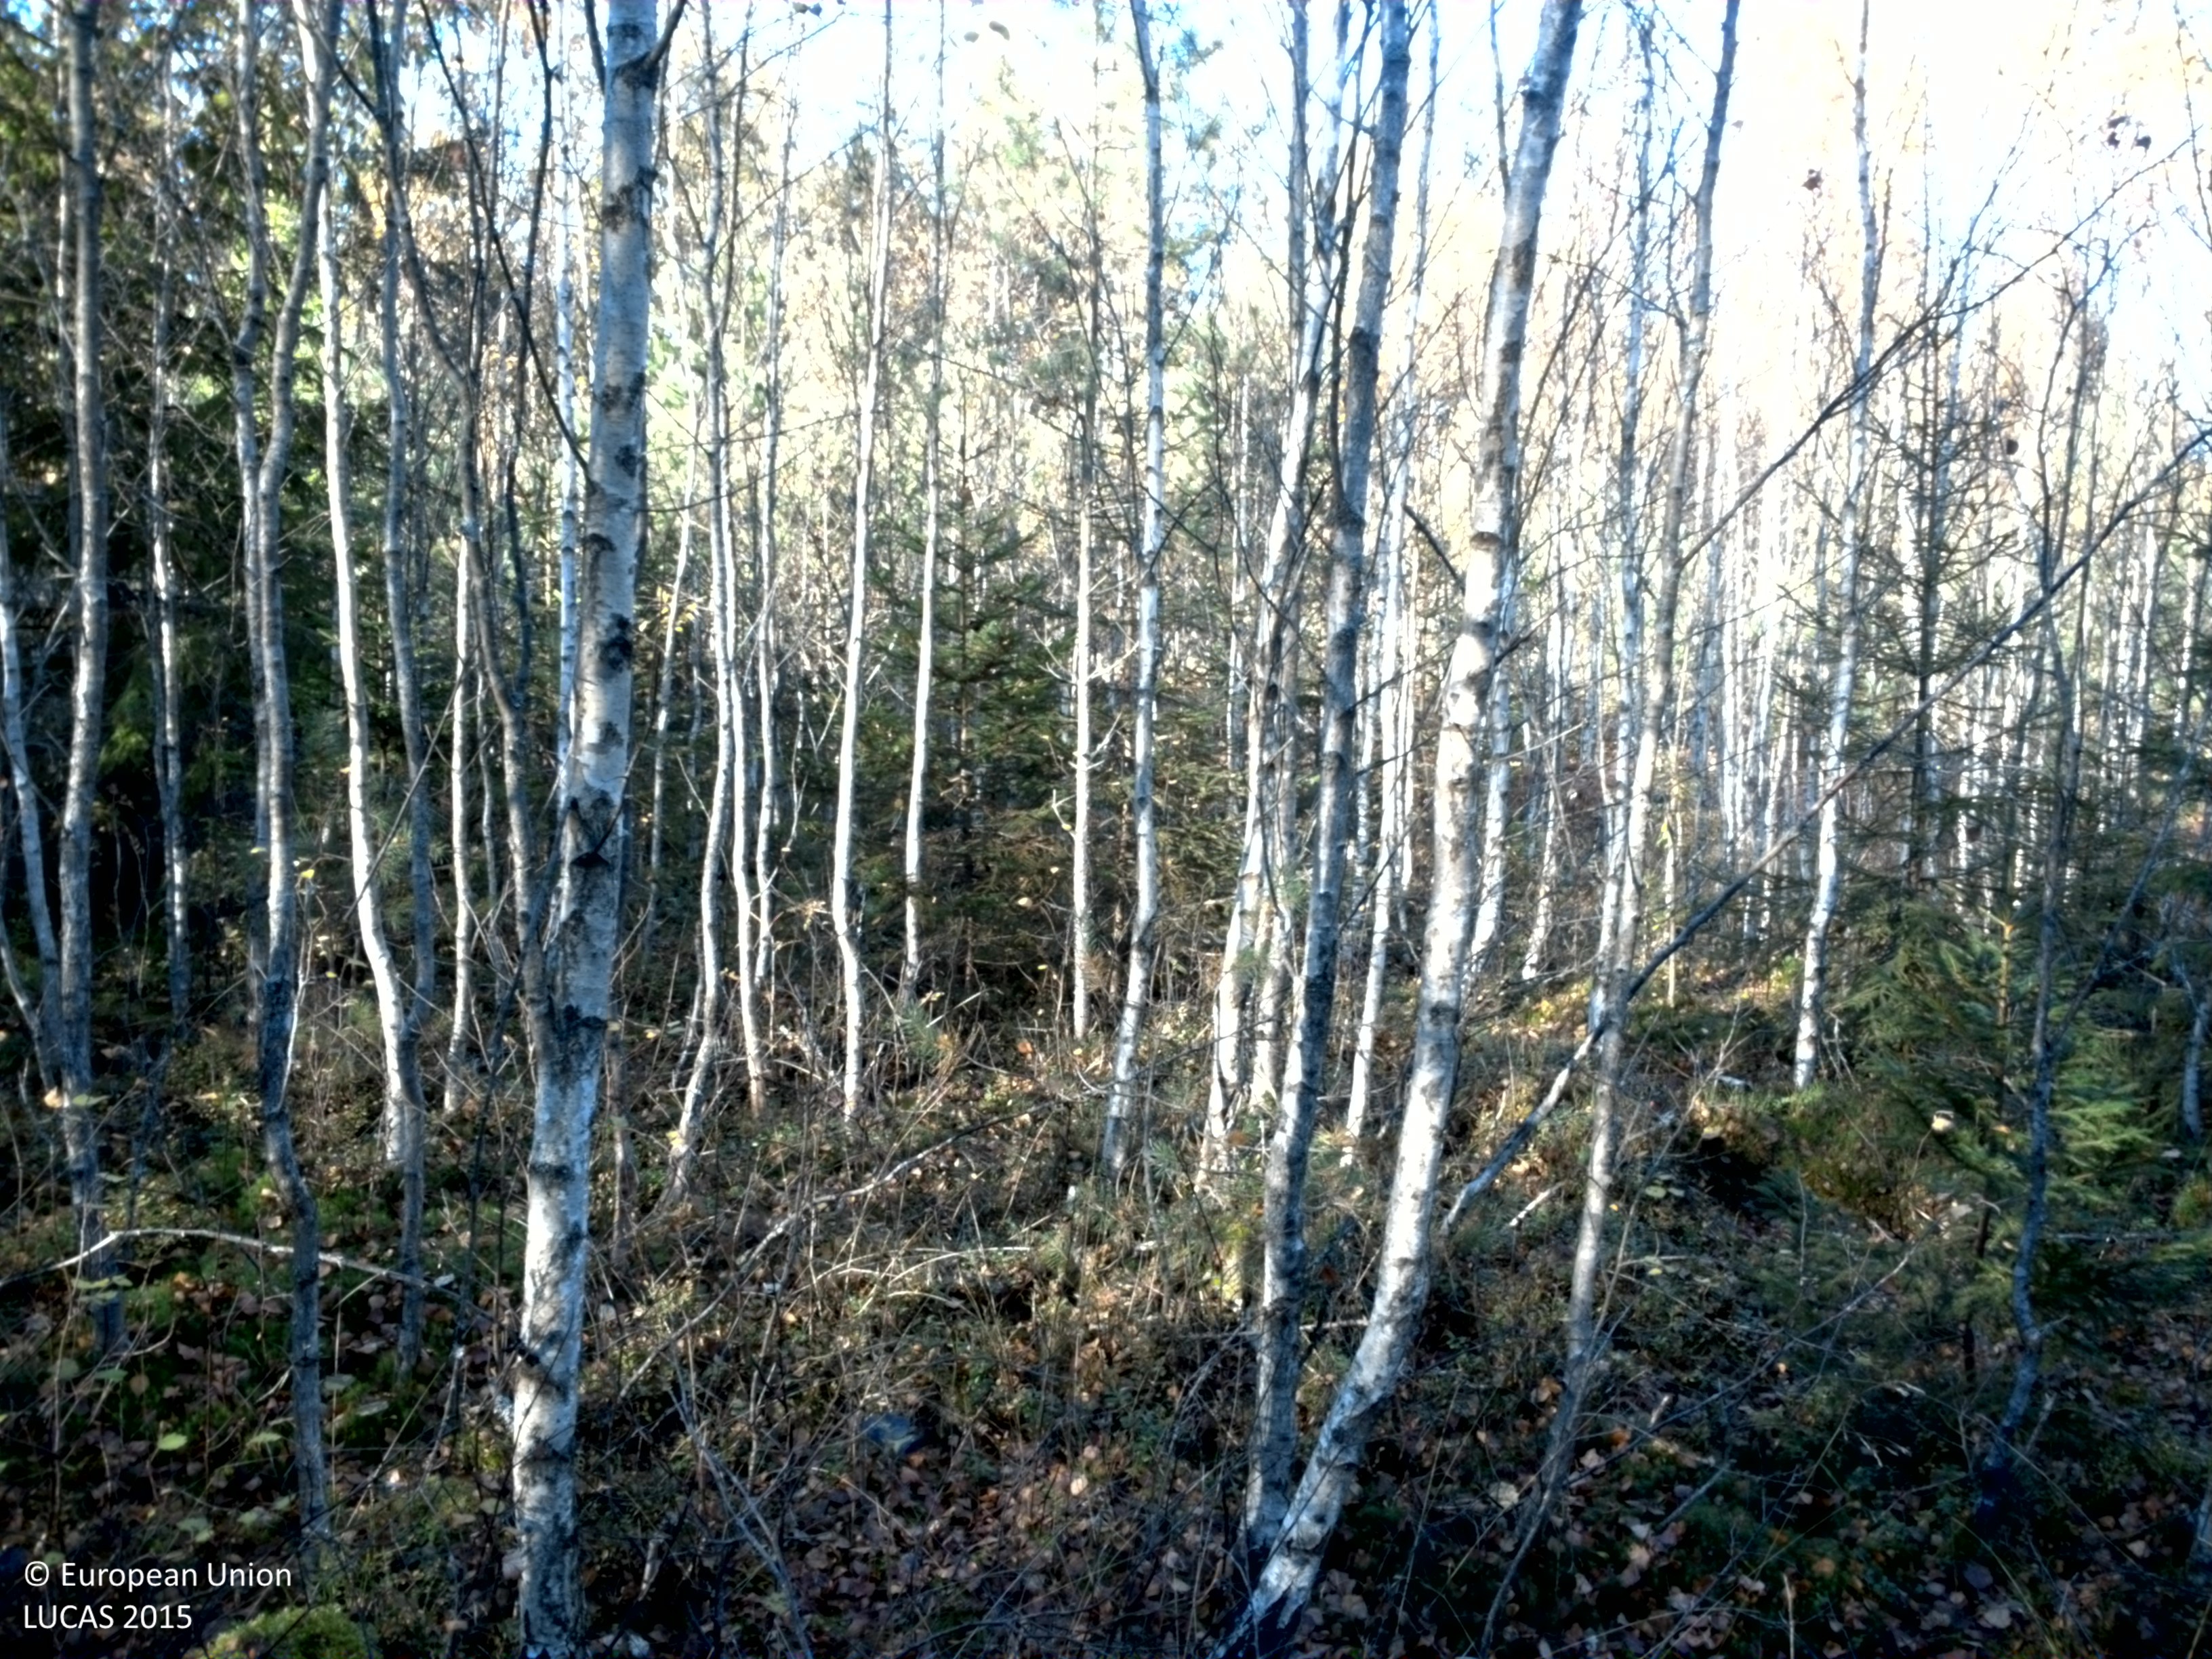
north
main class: Woodland
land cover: Spruce dominated mixed woodland
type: boreal forest
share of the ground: 25 - 50 %
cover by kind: broadleaved forest trees 35 %, herbaceous plants 20 %, lichens and mosses 20 %, coniferous forest trees 15 %, shrubs 10 %
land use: Forestry
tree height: > 5 m
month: October
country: SE
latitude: 59.1007
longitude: 13.1531
